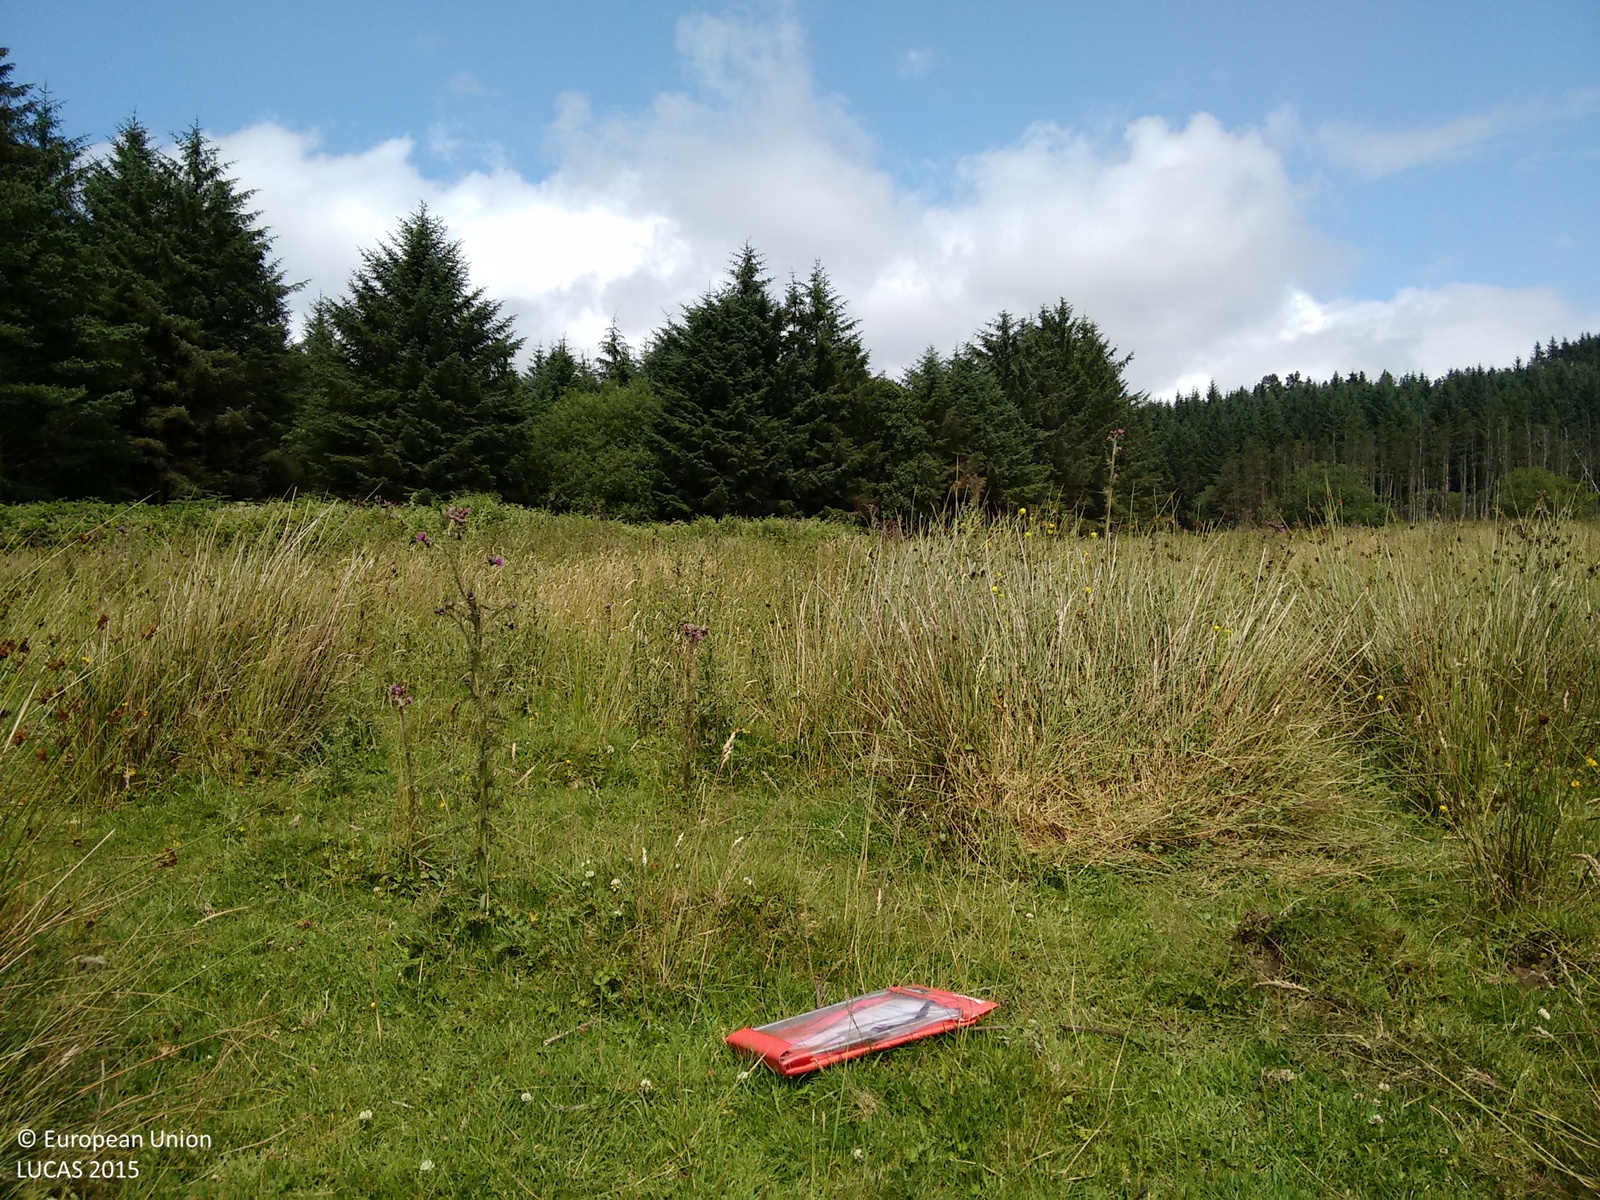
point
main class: Grassland
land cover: Grassland without tree/shrub cover
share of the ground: > 75 %
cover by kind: herbaceous plants 100 %
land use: Agriculture (excluding fallow land and kitchen gardens)
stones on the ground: < 10 %
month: July
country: GB
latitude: 51.6172
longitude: -3.6785
